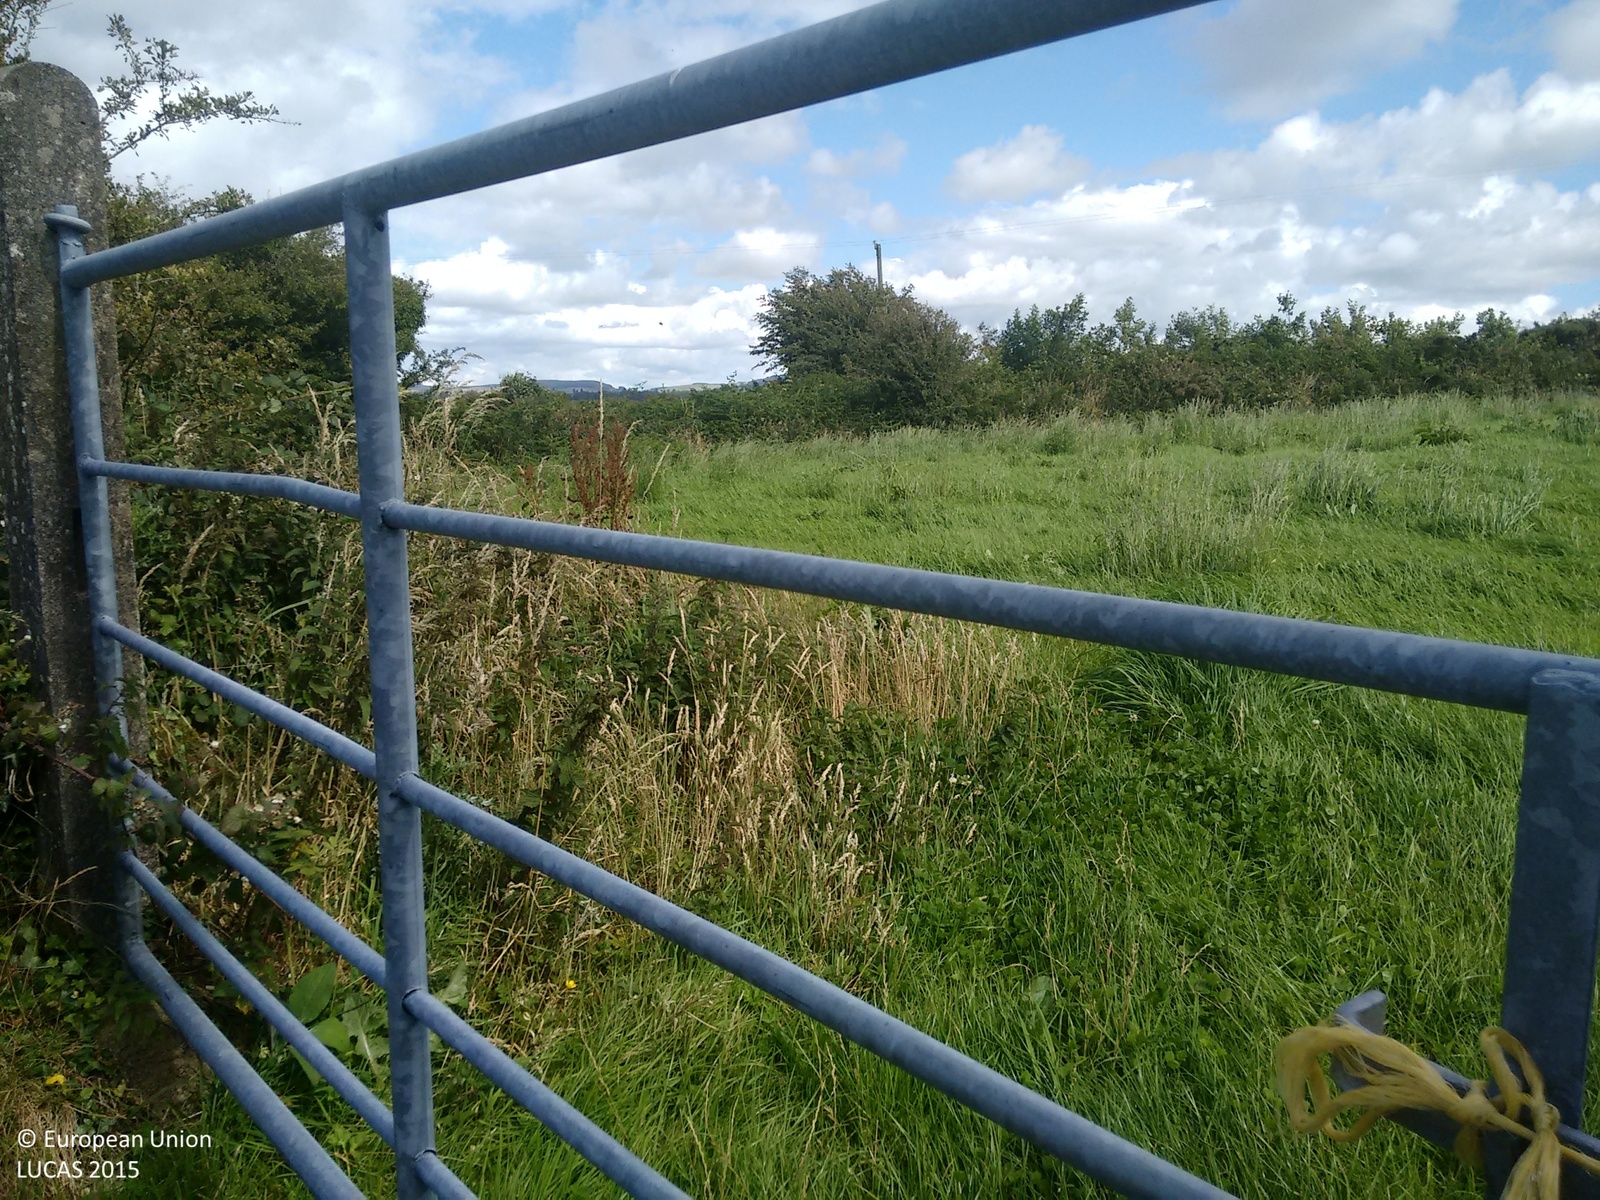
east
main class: Grassland
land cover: Grassland without tree/shrub cover
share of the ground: > 75 %
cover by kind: herbaceous plants 100 %
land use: Agriculture (excluding fallow land and kitchen gardens)
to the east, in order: Grassland without tree/shrub cover; Abandoned hedges; Grassland without tree/shrub cover; Tracks; Grassland without tree/shrub cover; Abandoned hedges; Grassland without tree/shrub cover; Fences; Tracks; Fences; Grassland without tree/shrub cover; Abandoned hedges
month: July
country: IE
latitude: 51.6185
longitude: -9.2138
